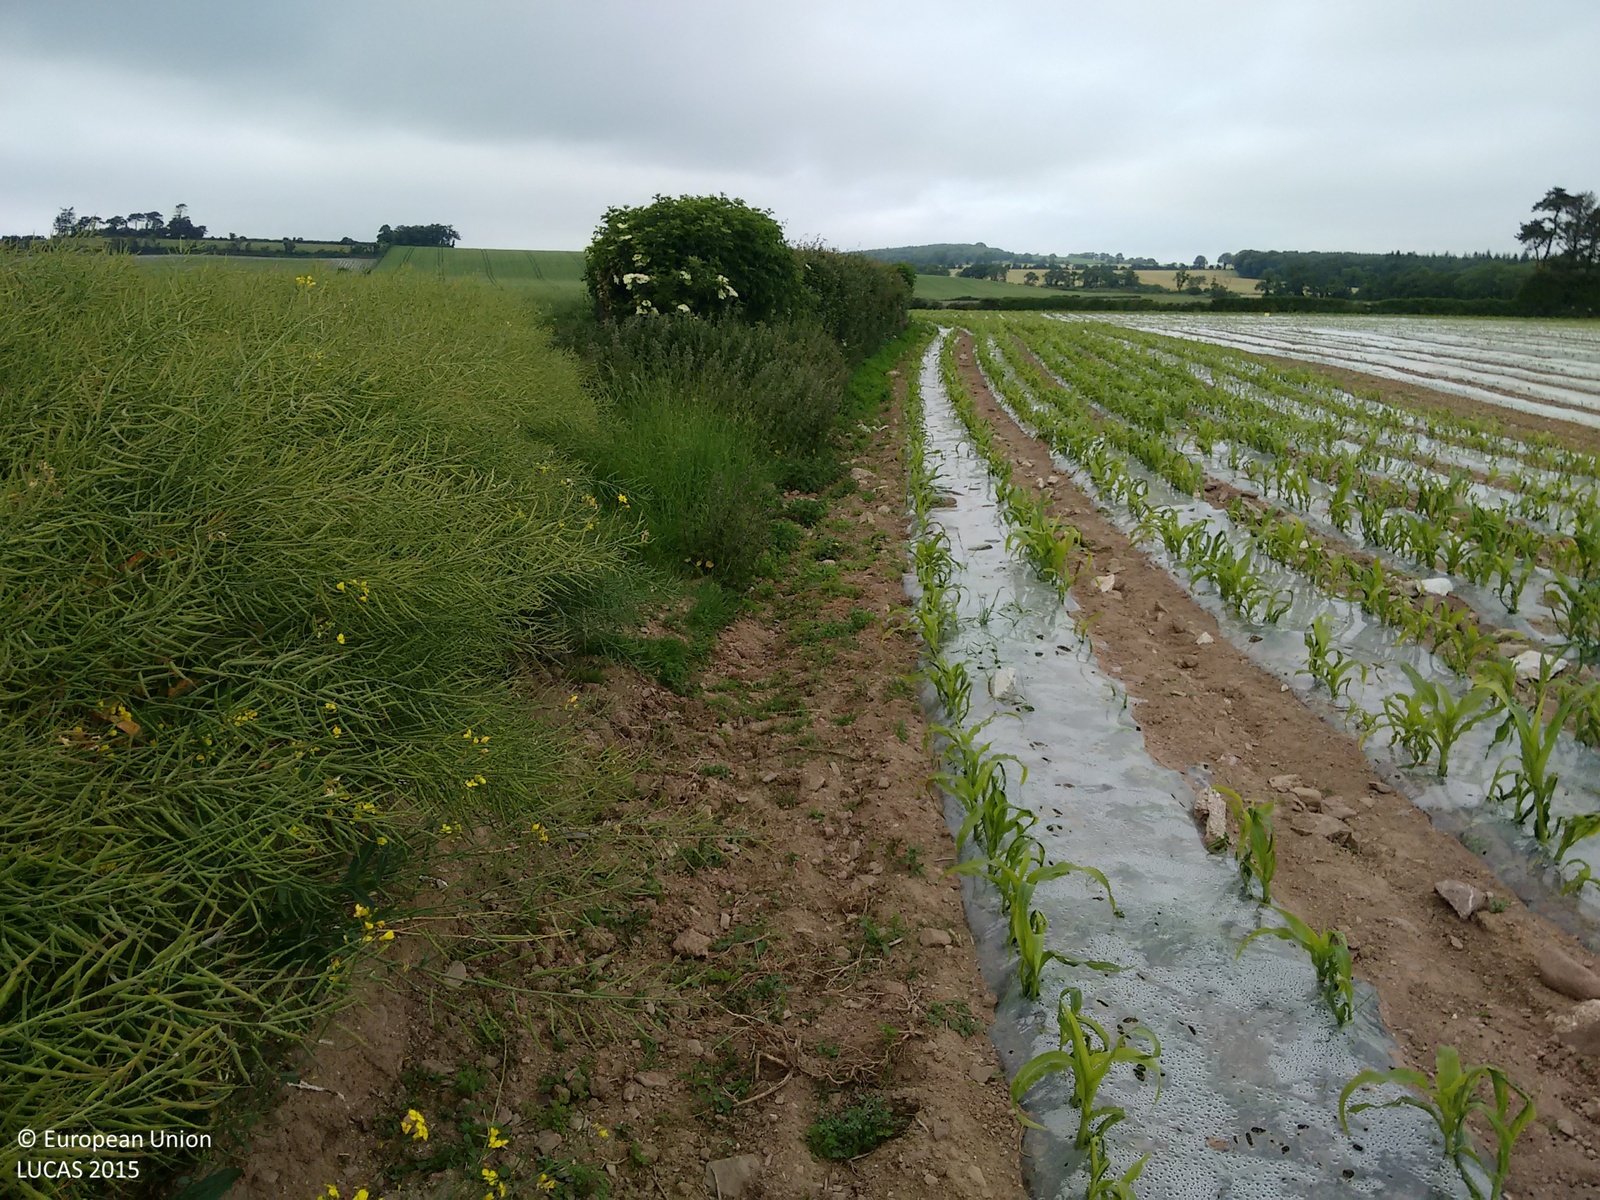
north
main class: Cropland
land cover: Rape and turnip rape
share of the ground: > 75 %
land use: Agriculture (excluding fallow land and kitchen gardens)
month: June
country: IE
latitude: 51.9355
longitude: -8.0536
